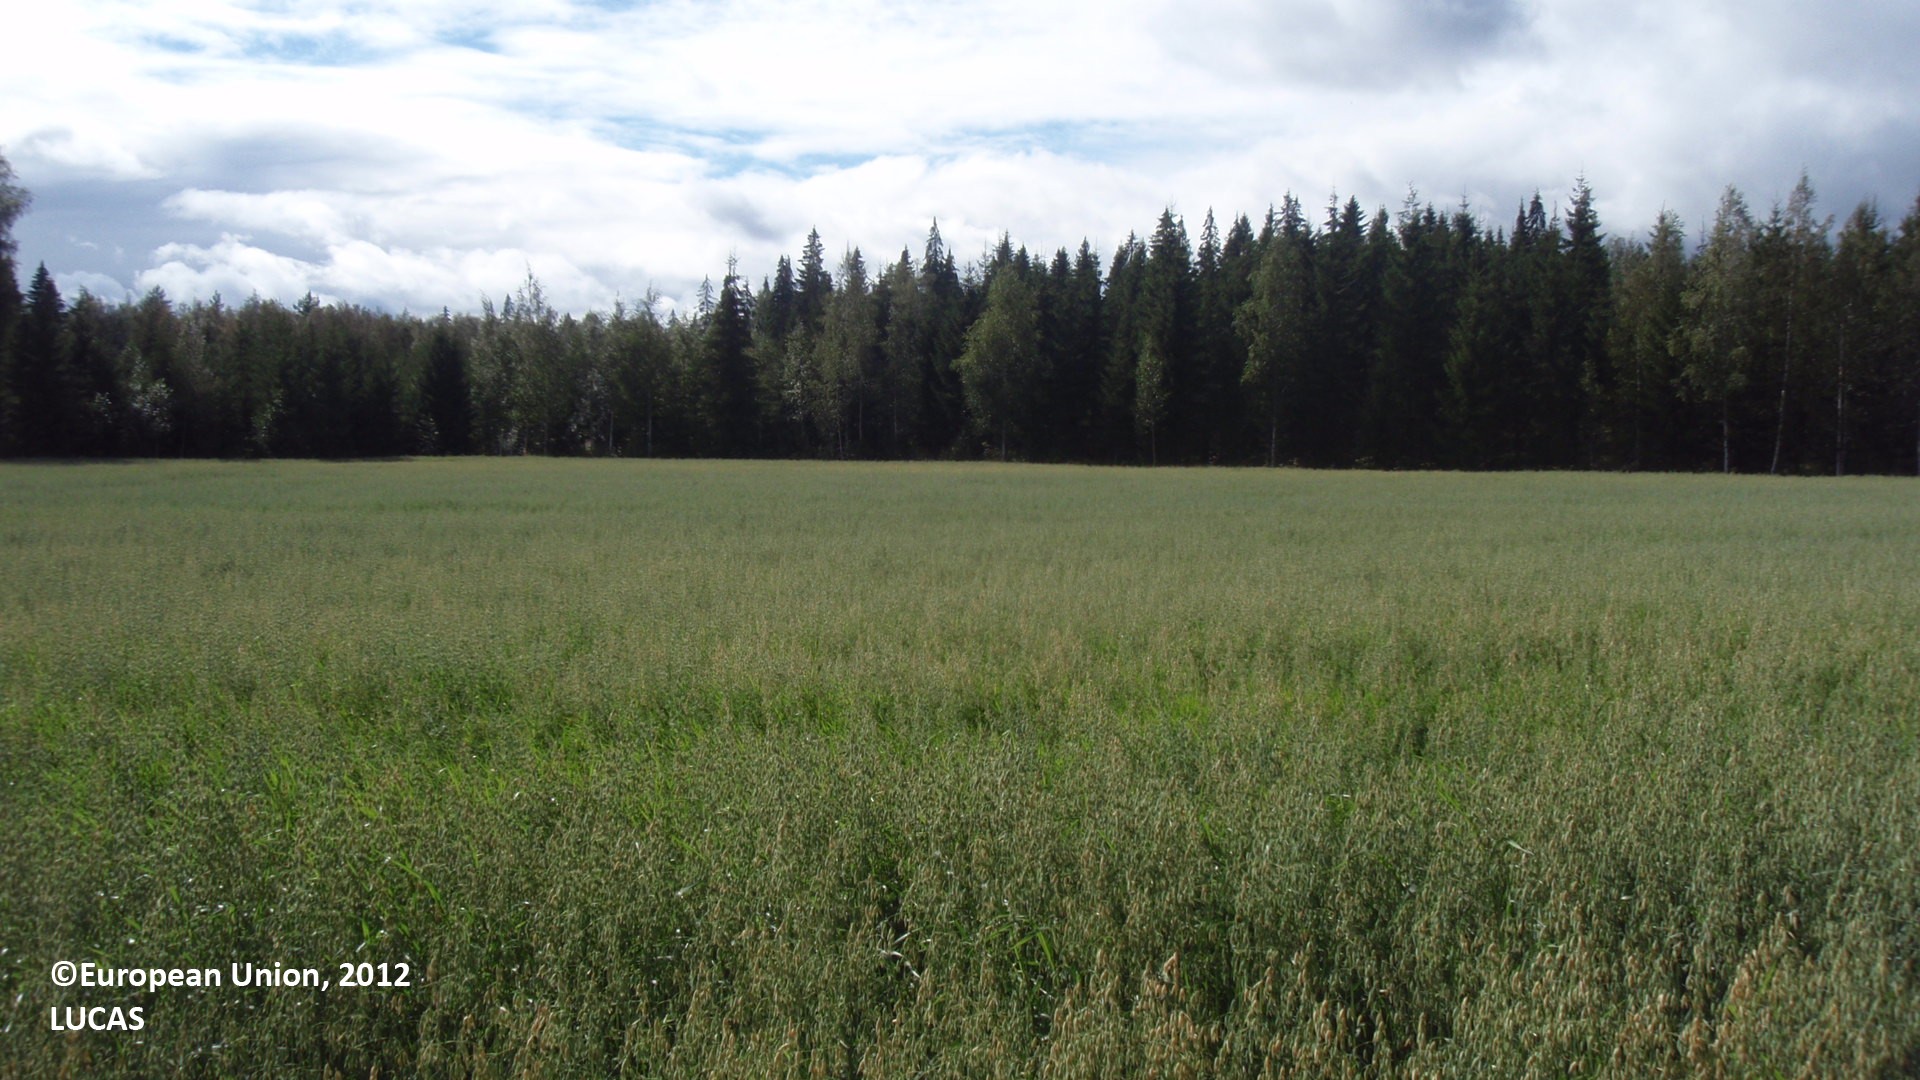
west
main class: Cropland
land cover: Oats
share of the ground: > 75 %
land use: Agriculture (excluding fallow land and kitchen gardens)
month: August
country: FI
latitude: 61.0506
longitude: 27.0775
